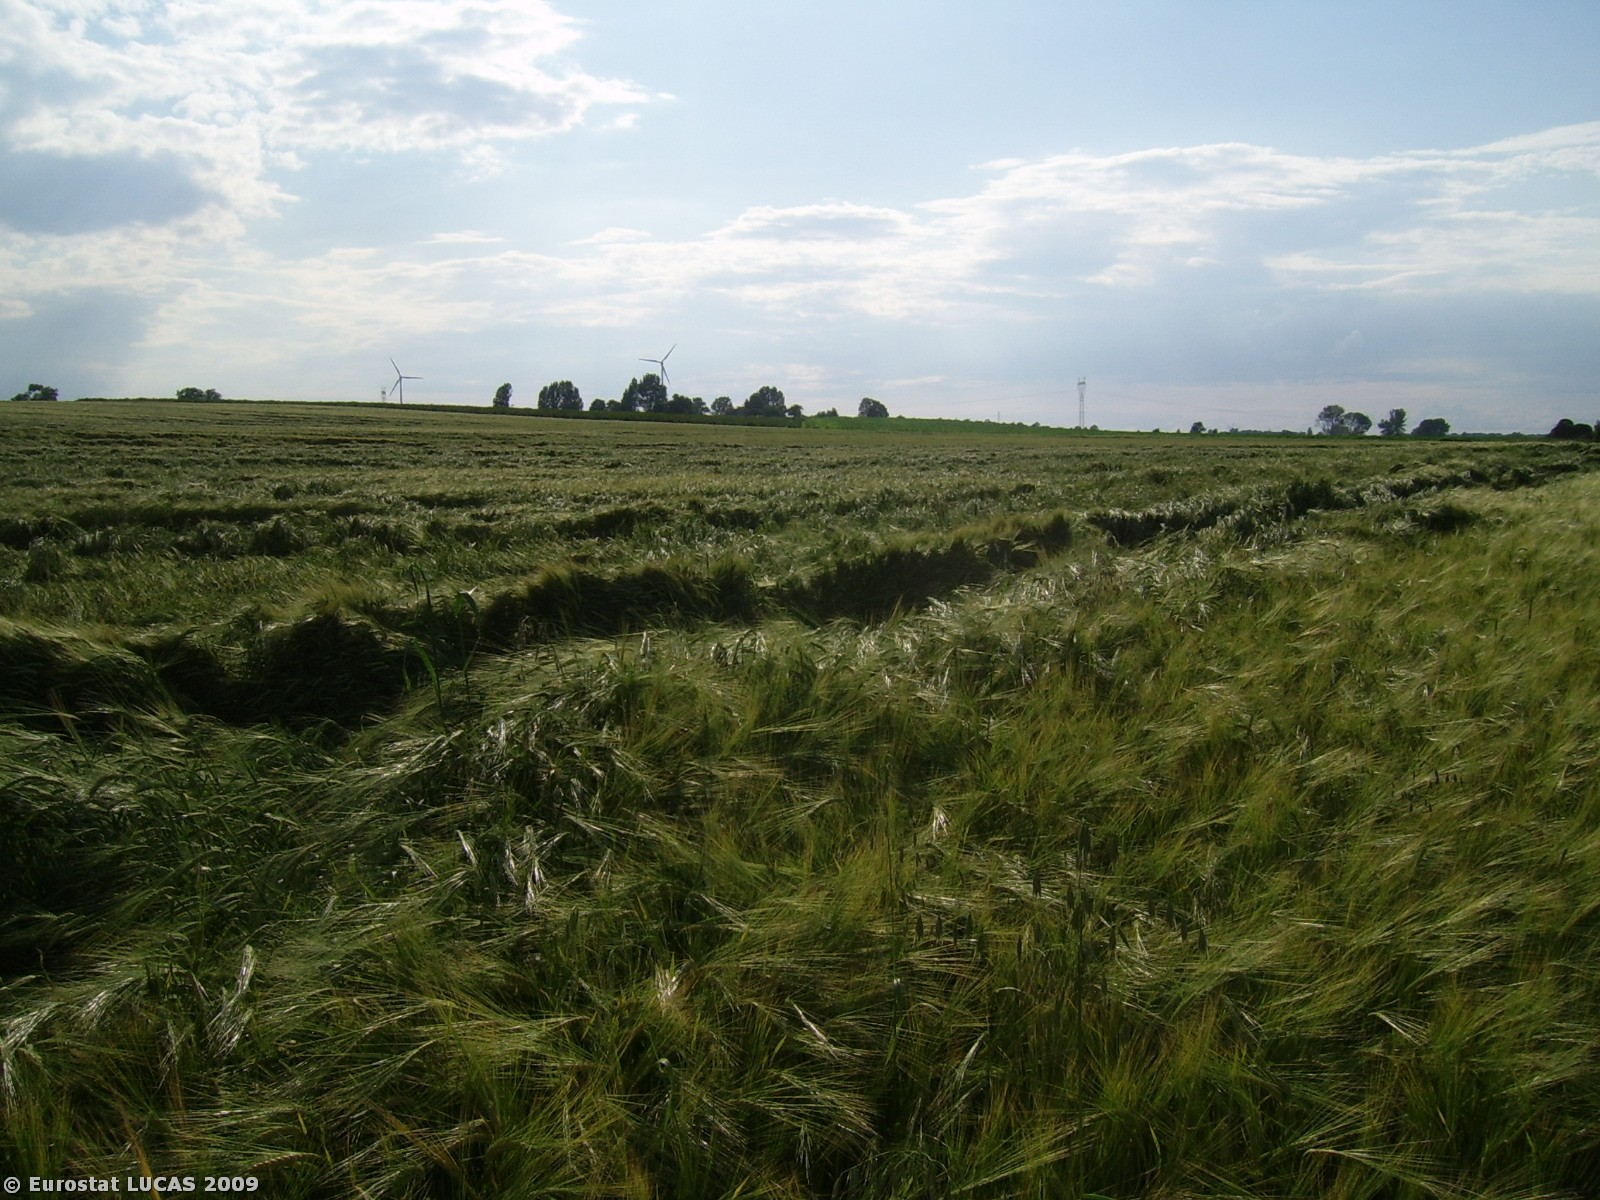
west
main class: Cropland
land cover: Barley
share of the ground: > 75 %
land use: Agriculture (excluding fallow land and kitchen gardens)
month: July
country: PL
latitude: 52.9260
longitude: 18.1829
